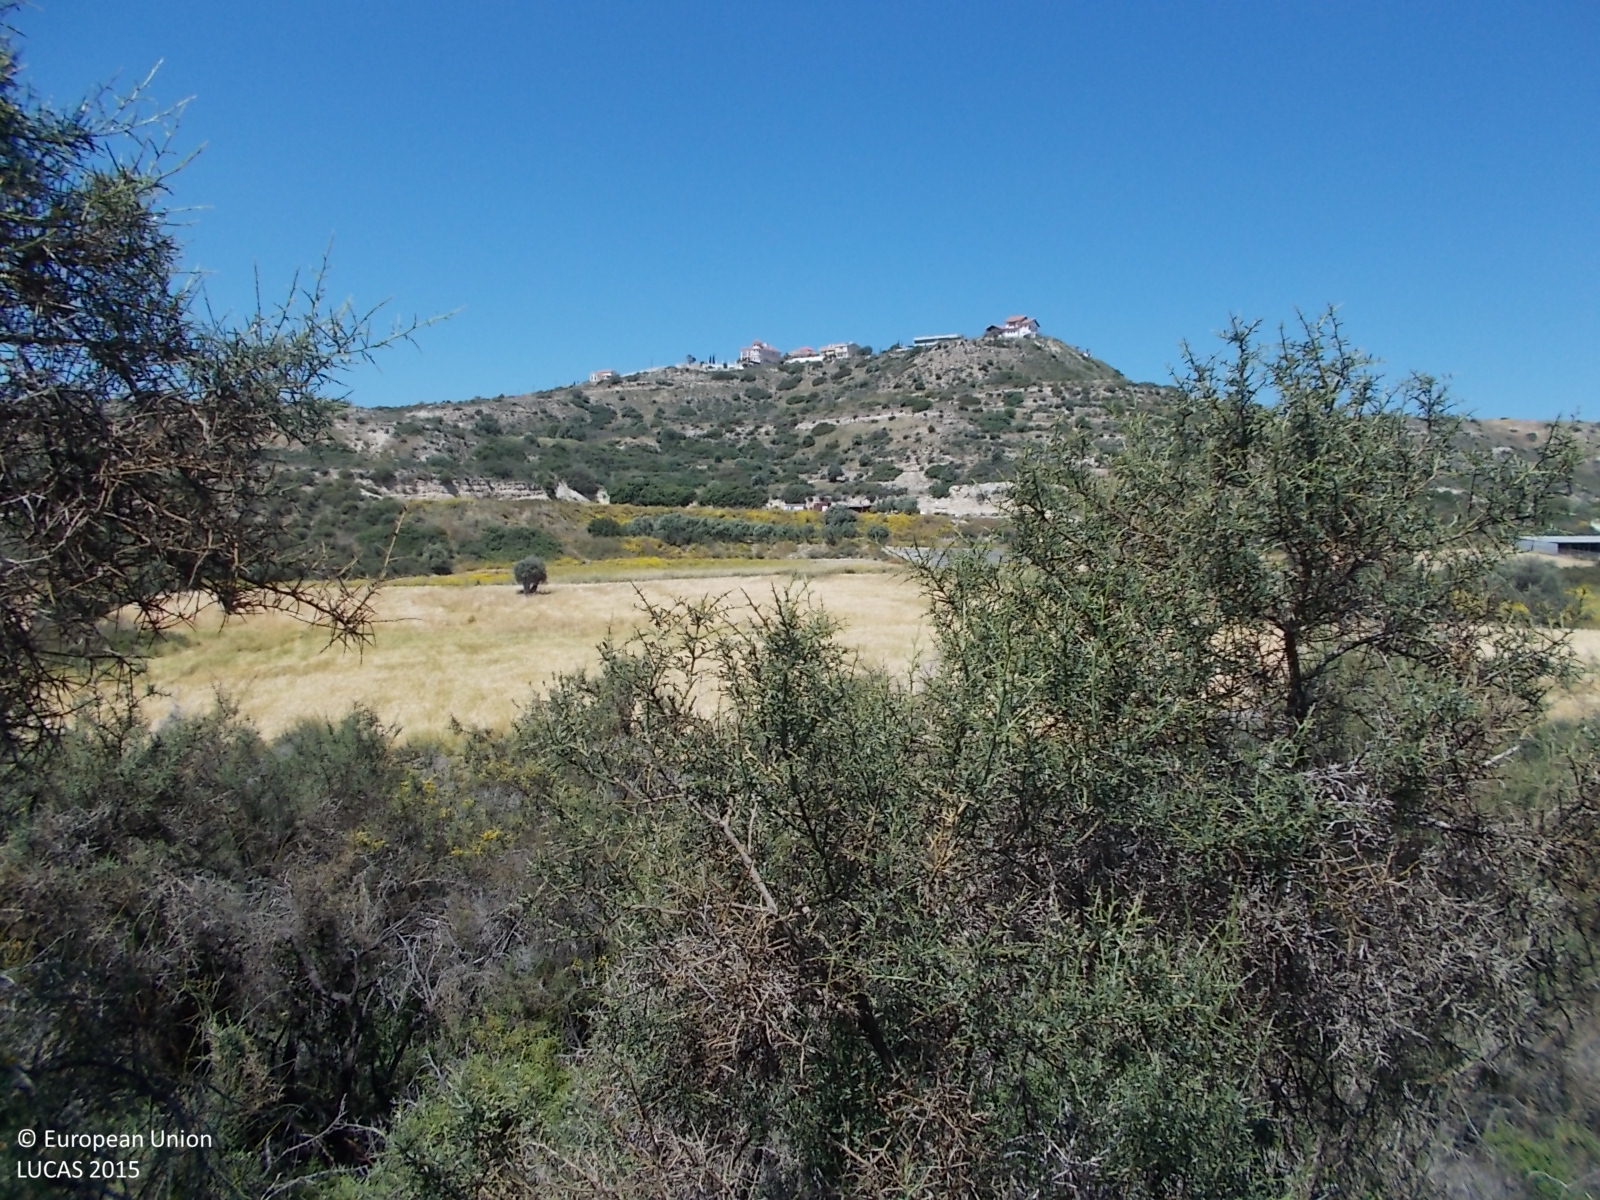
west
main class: Shrubland
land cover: Shrubland without tree cover
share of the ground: > 75 %
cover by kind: shrubs 100 %
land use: Semi-natural and natural areas not in use
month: April
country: CY
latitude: 34.7262
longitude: 33.0448
